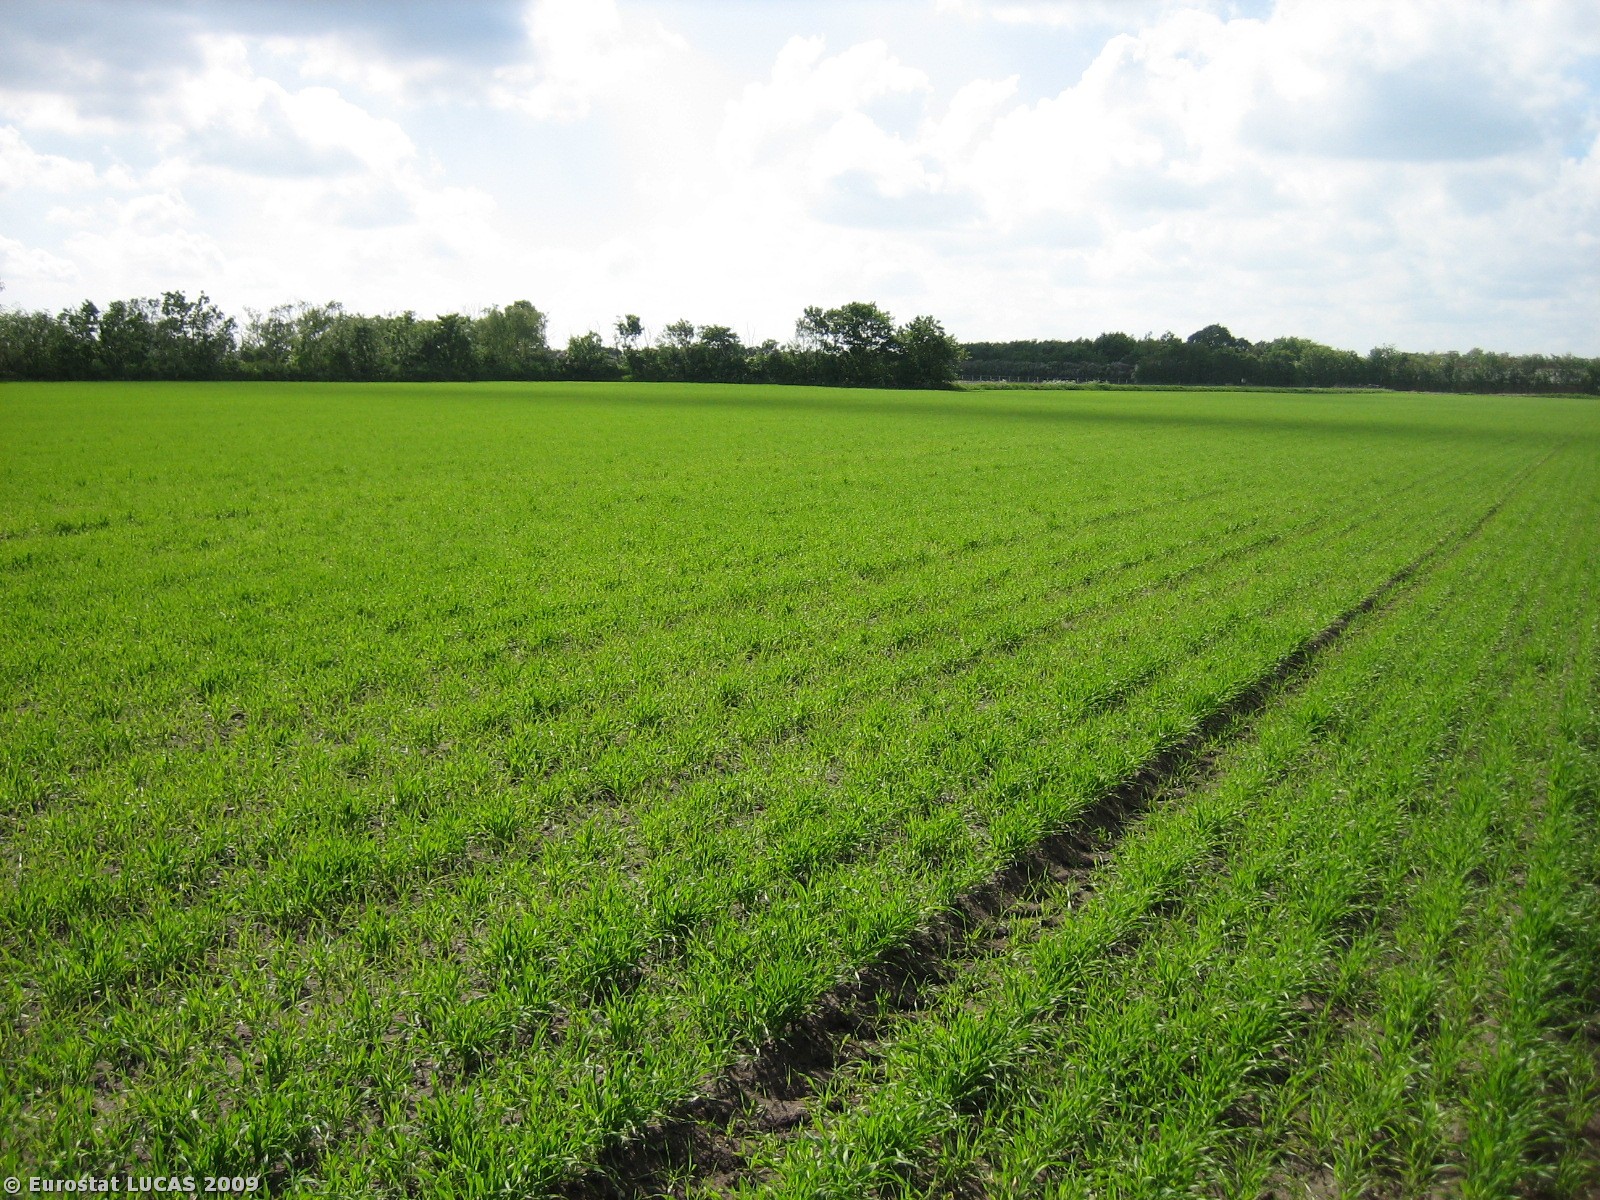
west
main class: Cropland
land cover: Barley
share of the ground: 50 - 75 %
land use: Agriculture (excluding fallow land and kitchen gardens)
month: May
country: DK
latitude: 56.2736
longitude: 8.9838
